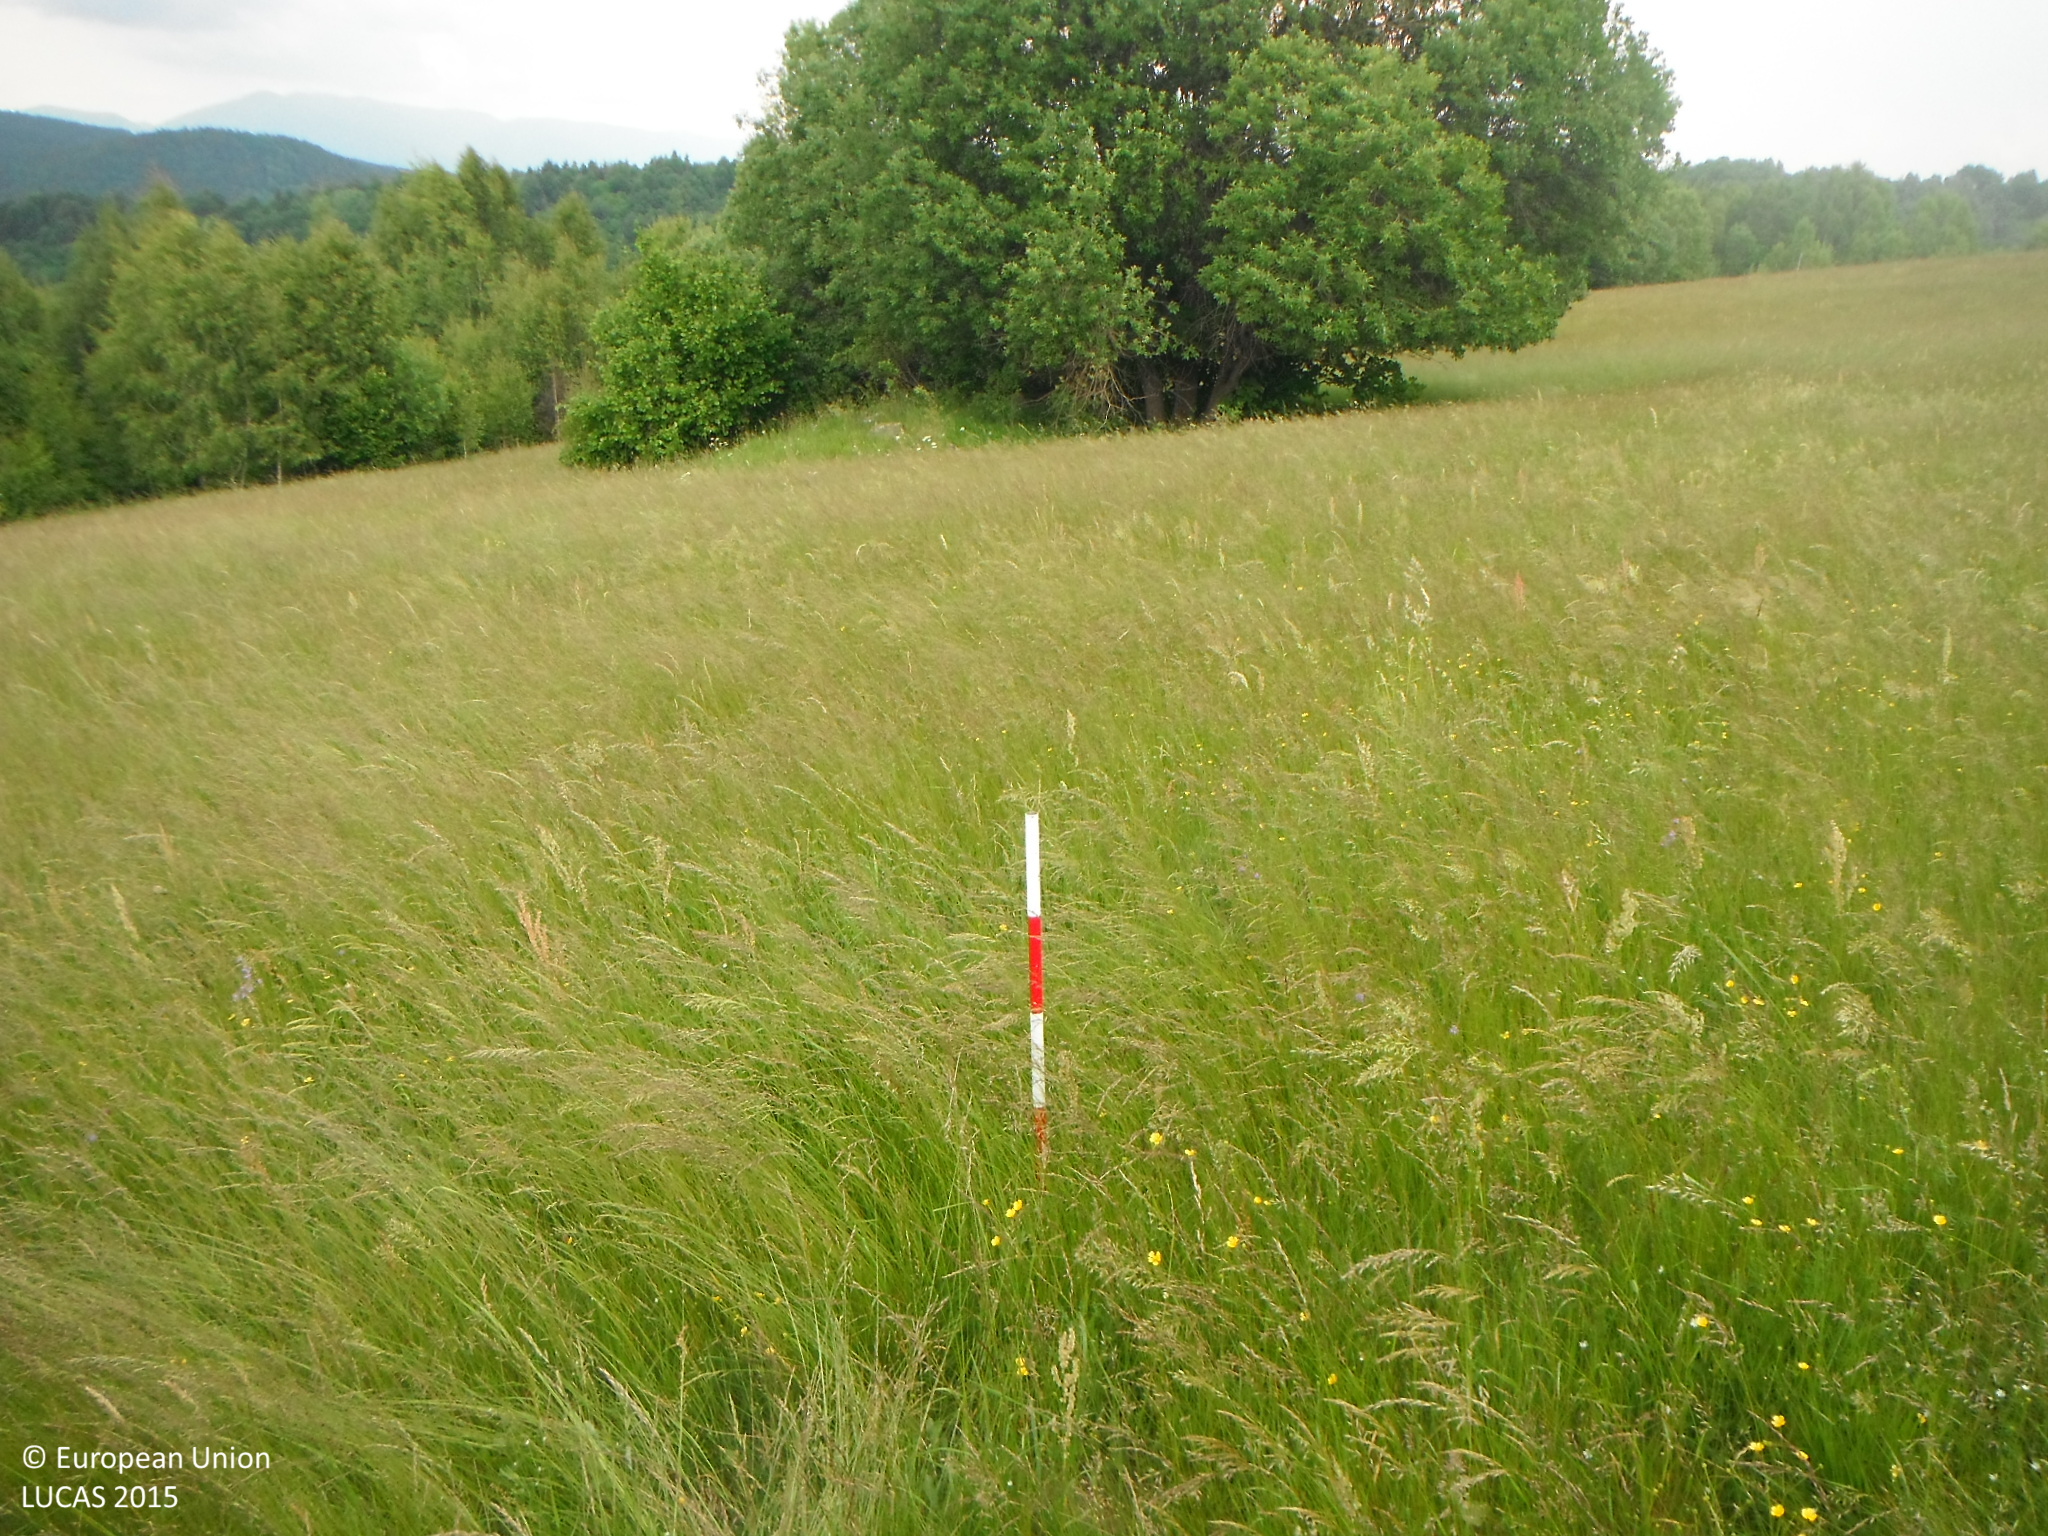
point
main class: Grassland
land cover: Grassland without tree/shrub cover
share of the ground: > 75 %
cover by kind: herbaceous plants 100 %
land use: Agriculture (excluding fallow land and kitchen gardens)
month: June
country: SK
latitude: 48.6763
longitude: 19.3540
